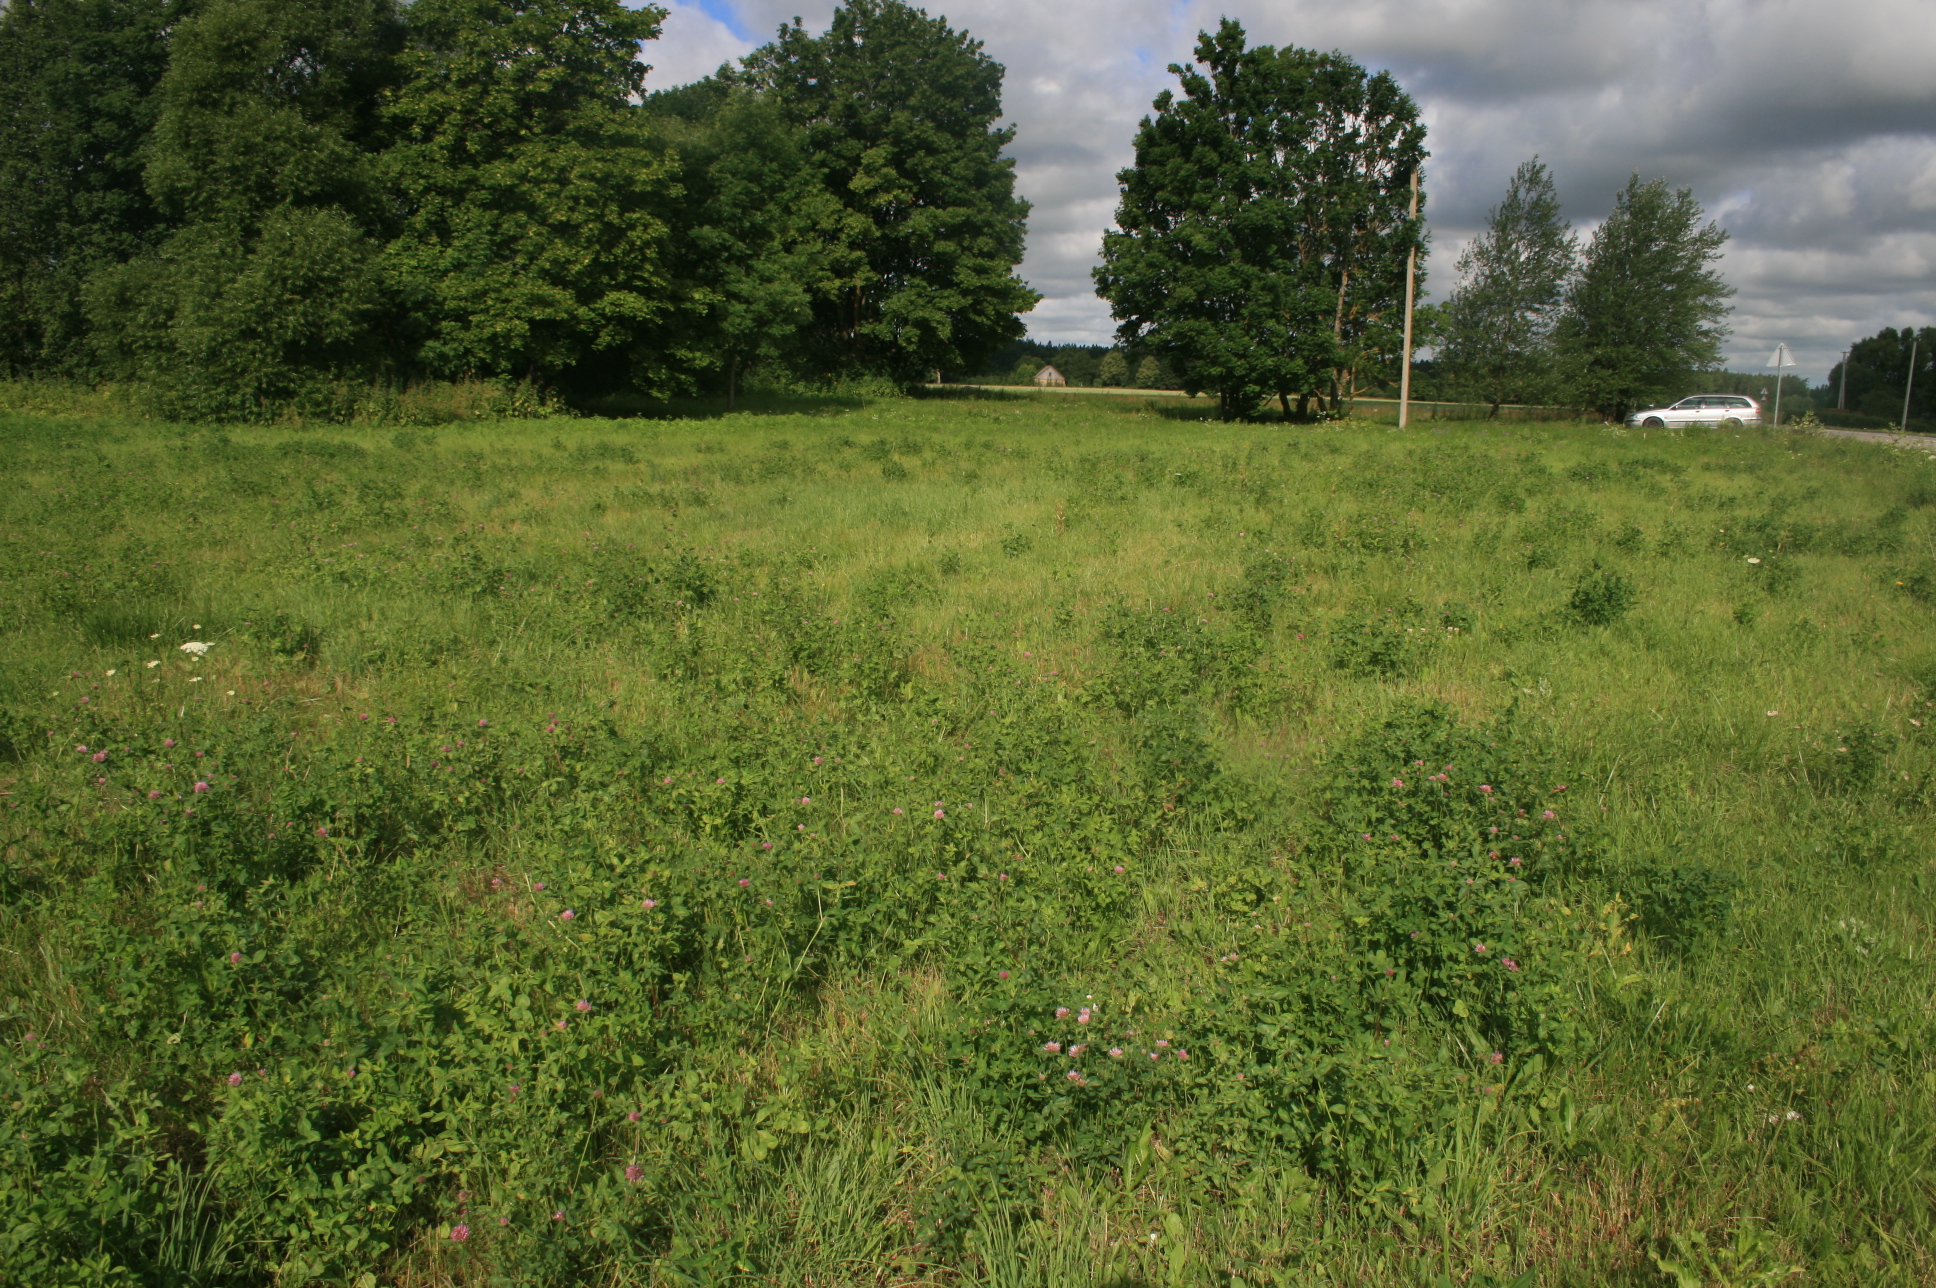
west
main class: Grassland
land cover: Grassland without tree/shrub cover
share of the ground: > 75 %
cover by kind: herbaceous plants 100 %
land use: Agriculture (excluding fallow land and kitchen gardens)
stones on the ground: < 10 %
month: July
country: LT
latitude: 55.8622
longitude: 21.3712
